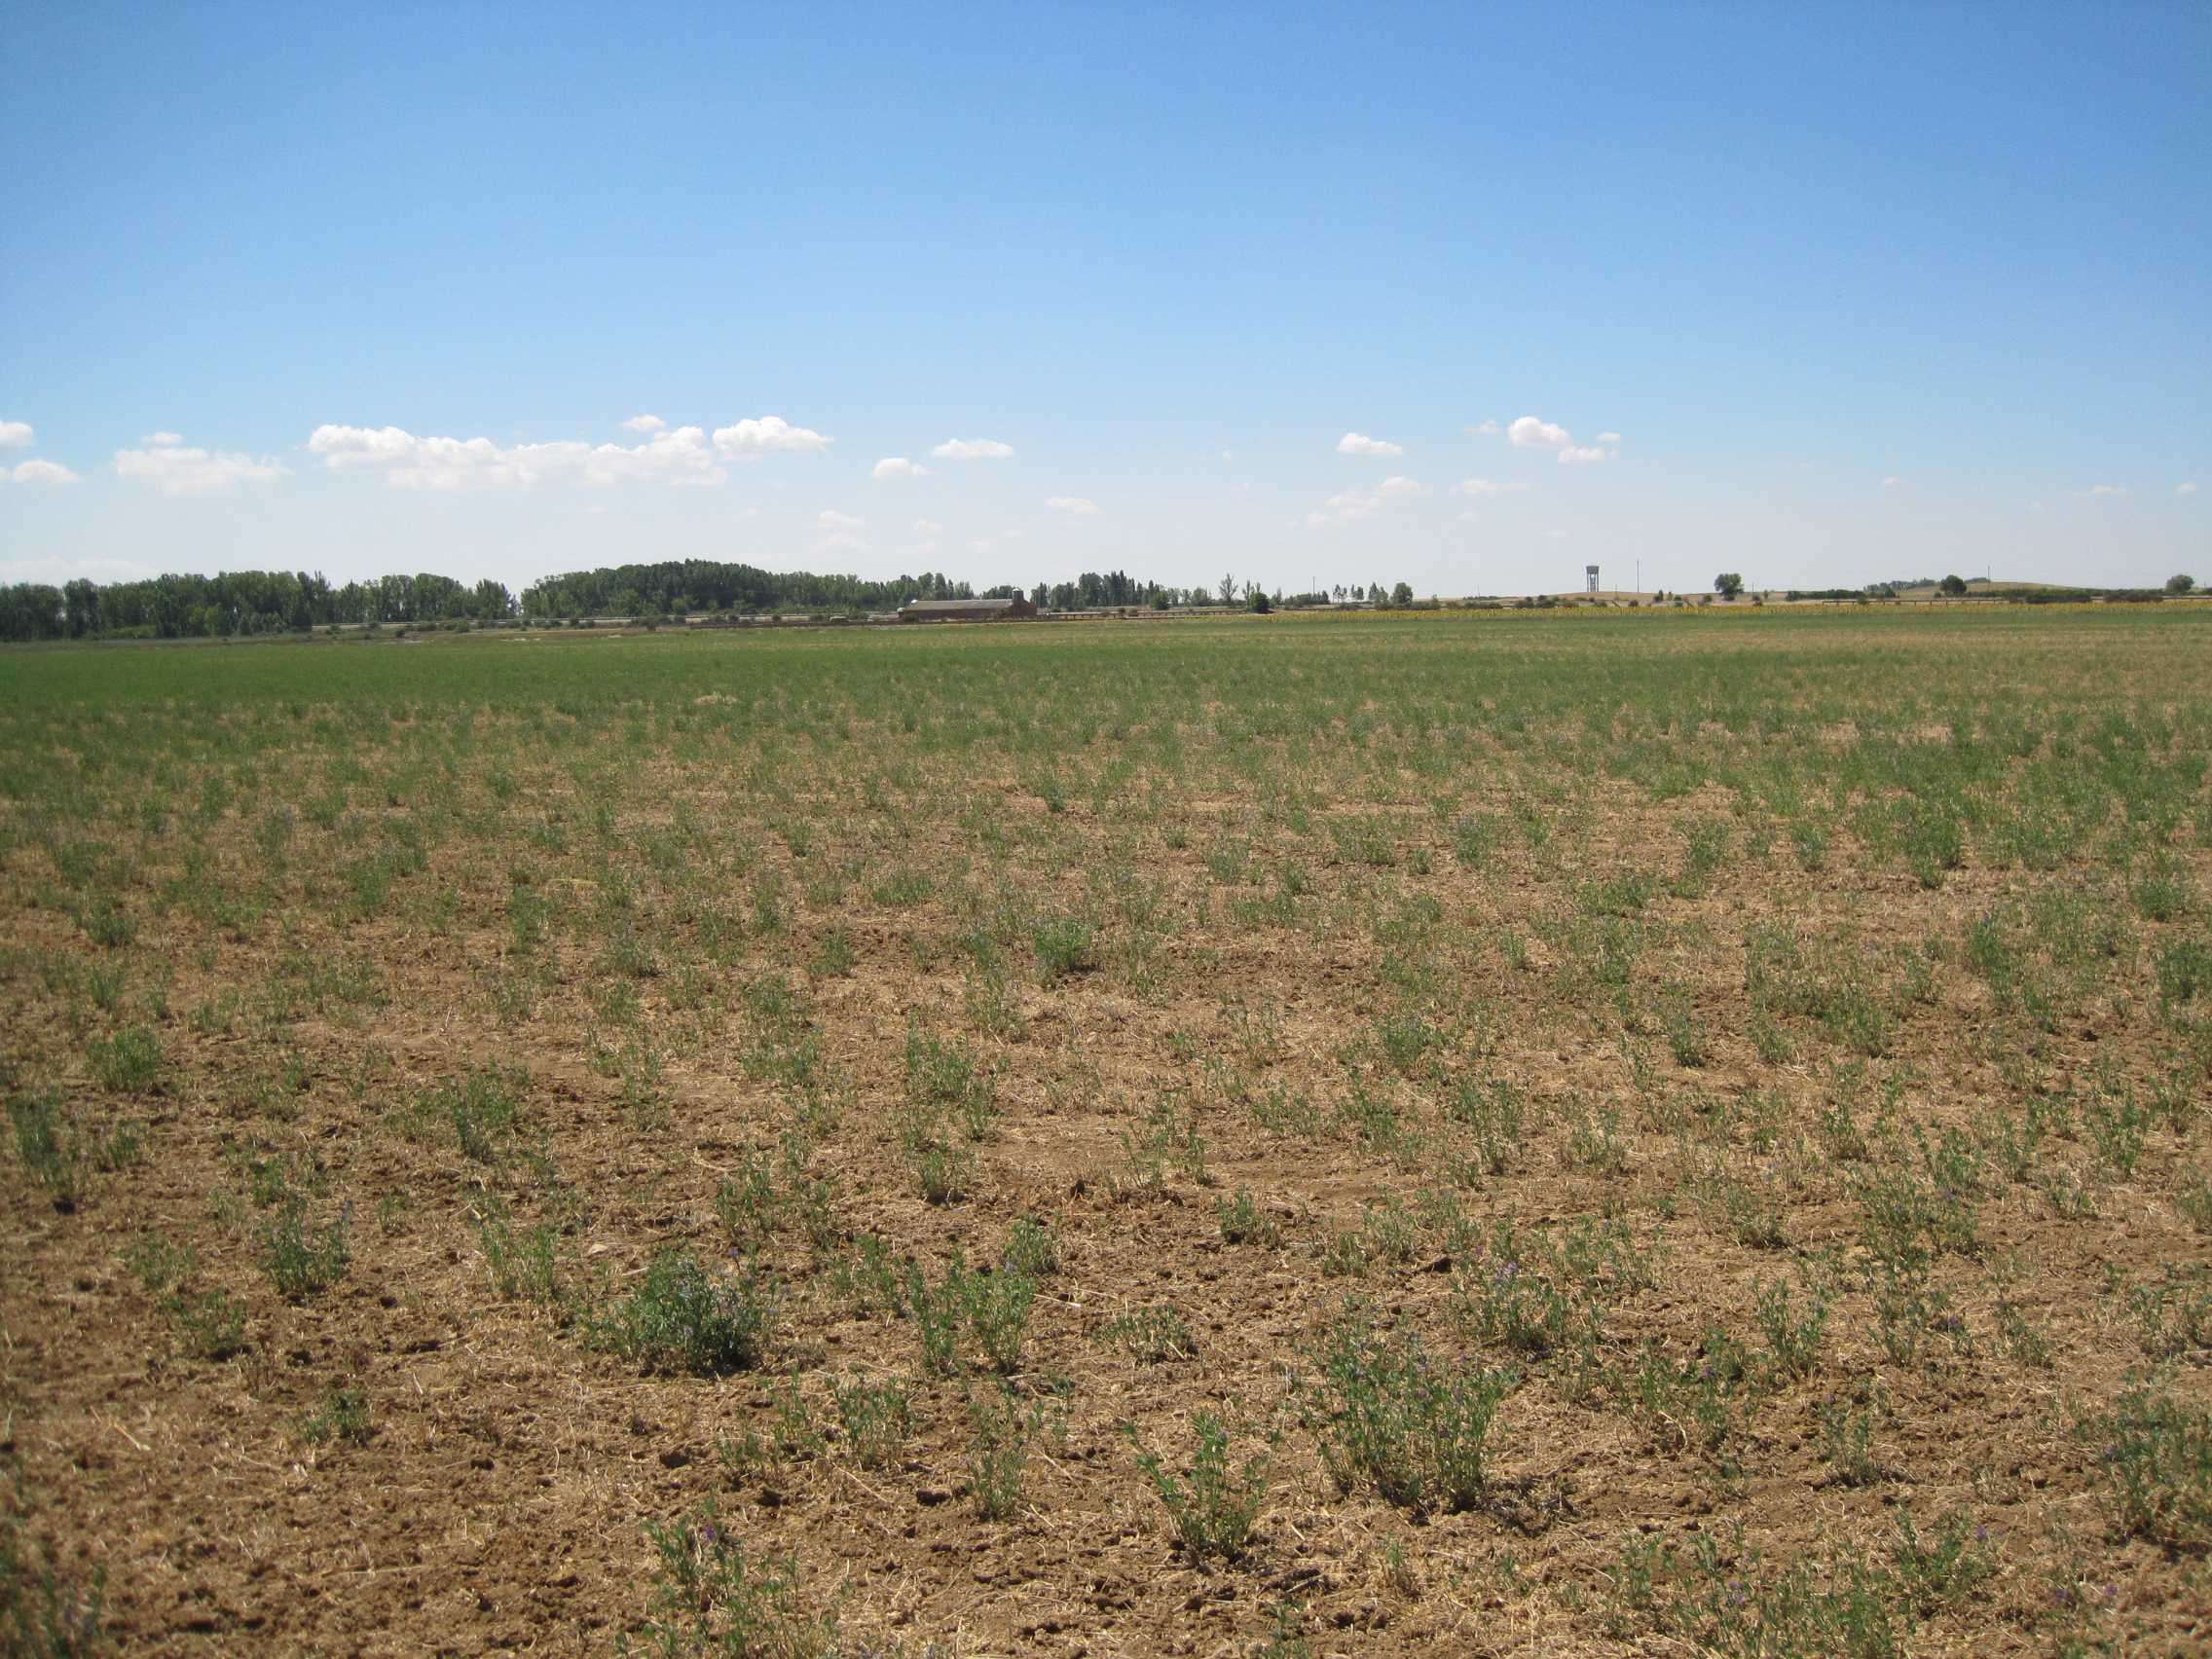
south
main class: Cropland
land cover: Lucerne
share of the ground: 25 - 50 %
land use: Agriculture (excluding fallow land and kitchen gardens)
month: July
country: ES
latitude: 42.0434
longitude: -4.8759
